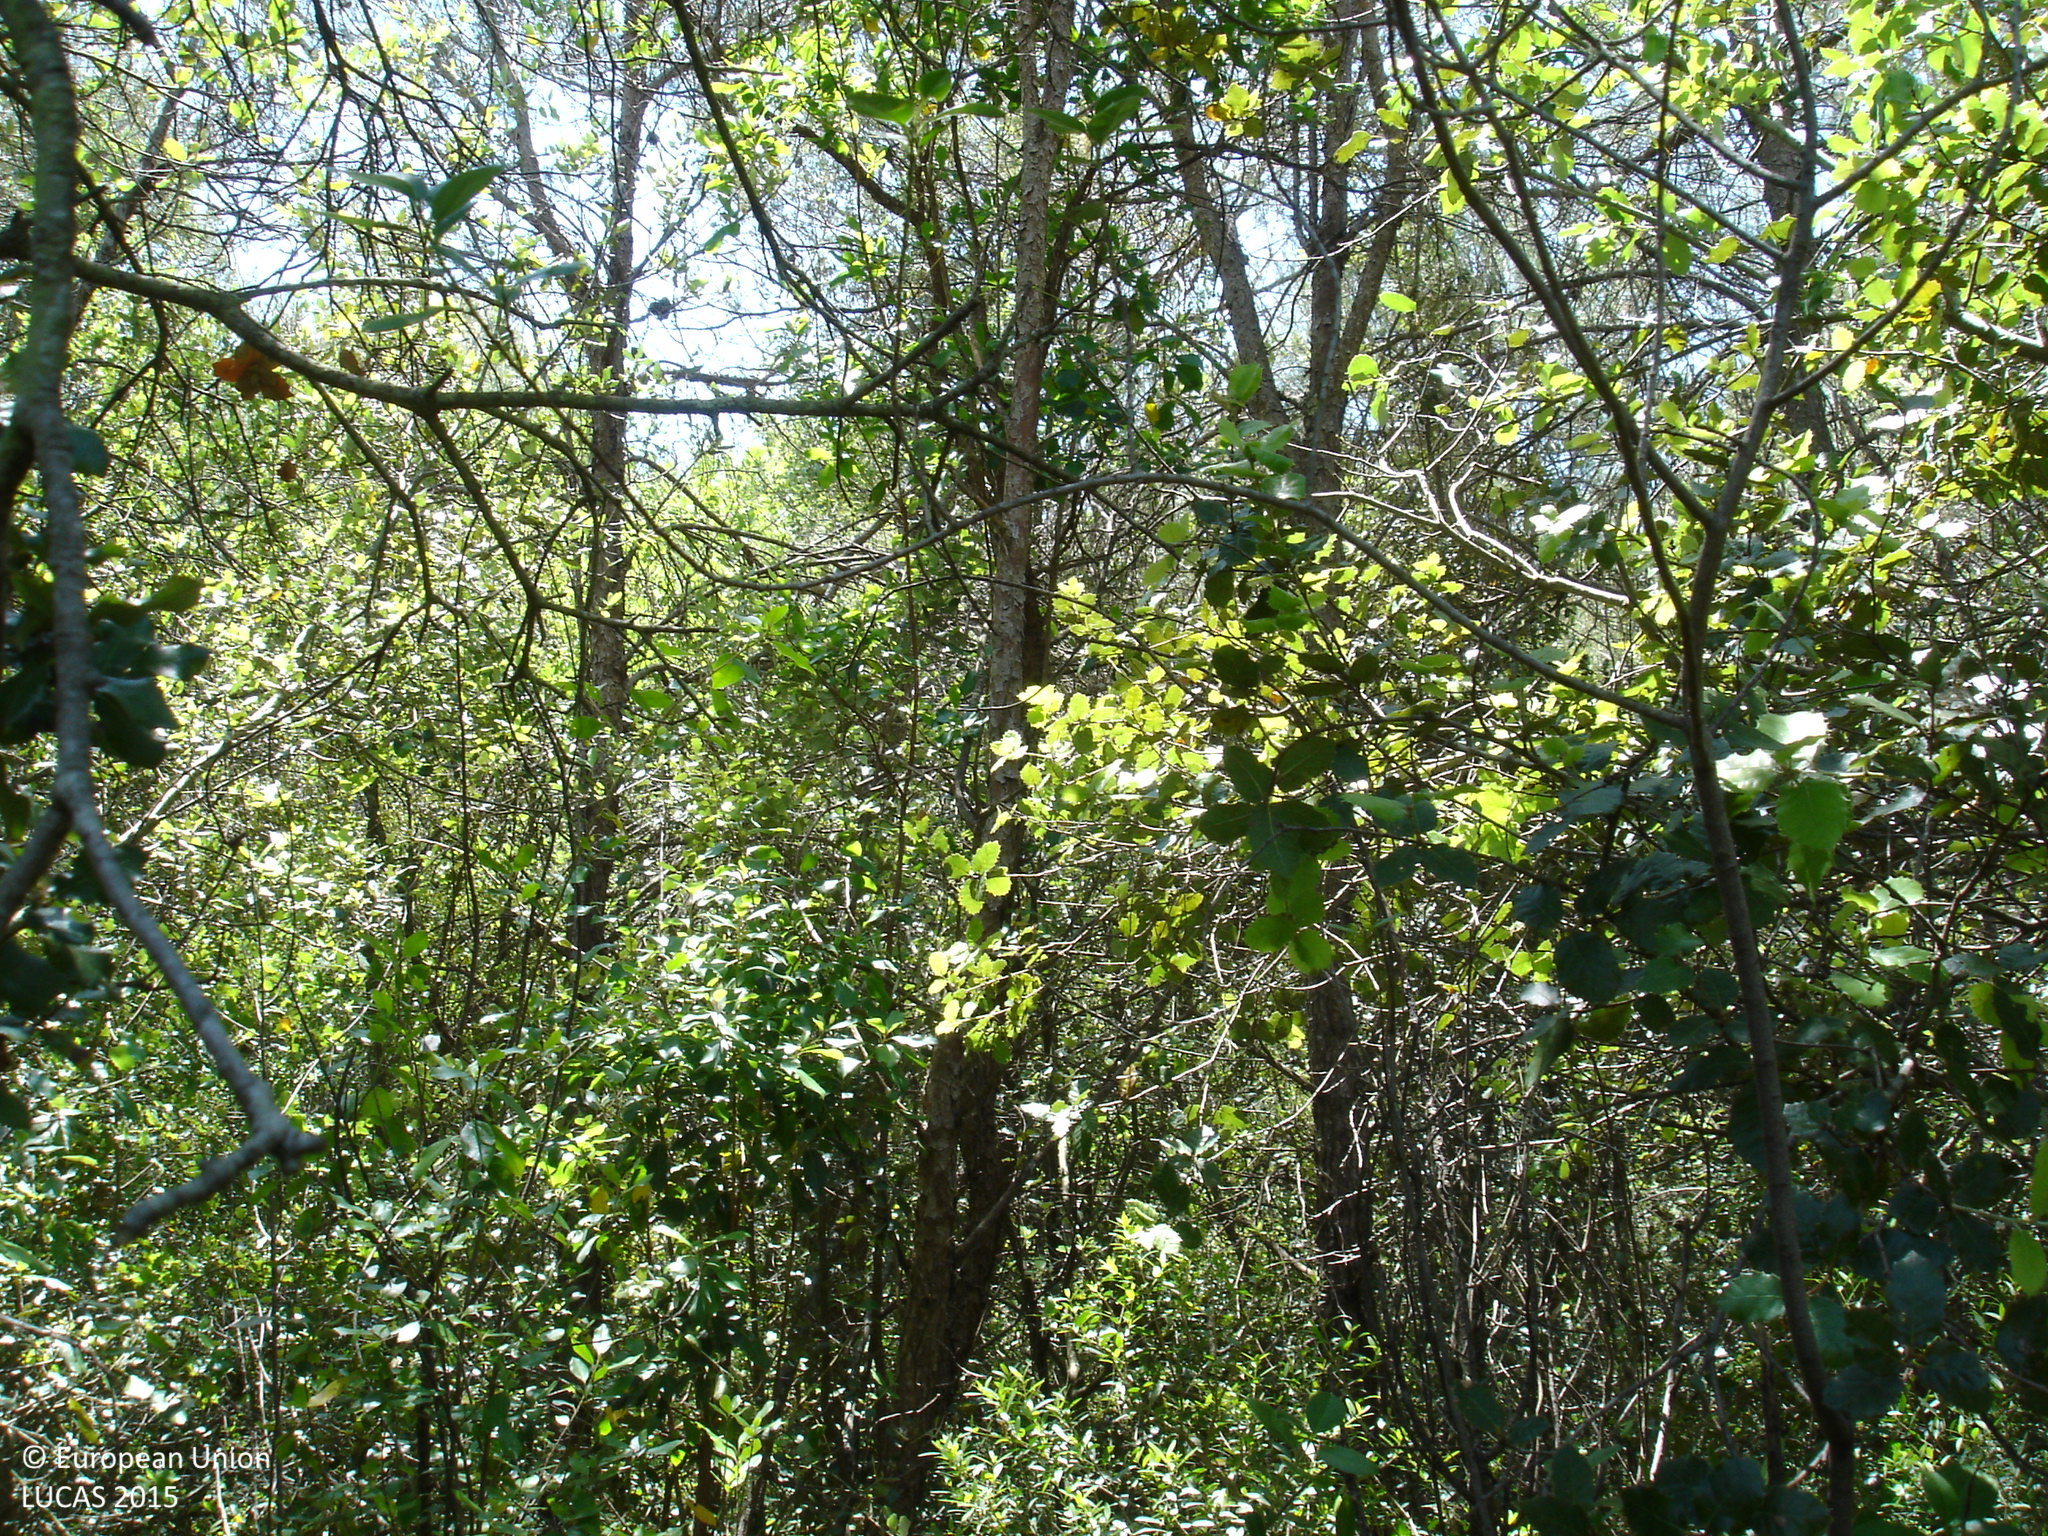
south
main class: Woodland
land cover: Other mixed woodland
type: coniferous forest of the mediterranean region
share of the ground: > 75 %
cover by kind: coniferous forest trees 50 %, broadleaved forest trees 40 %, shrubs 10 %
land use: Forestry
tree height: > 5 m
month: May
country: ES
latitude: 42.1208
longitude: 2.9874
